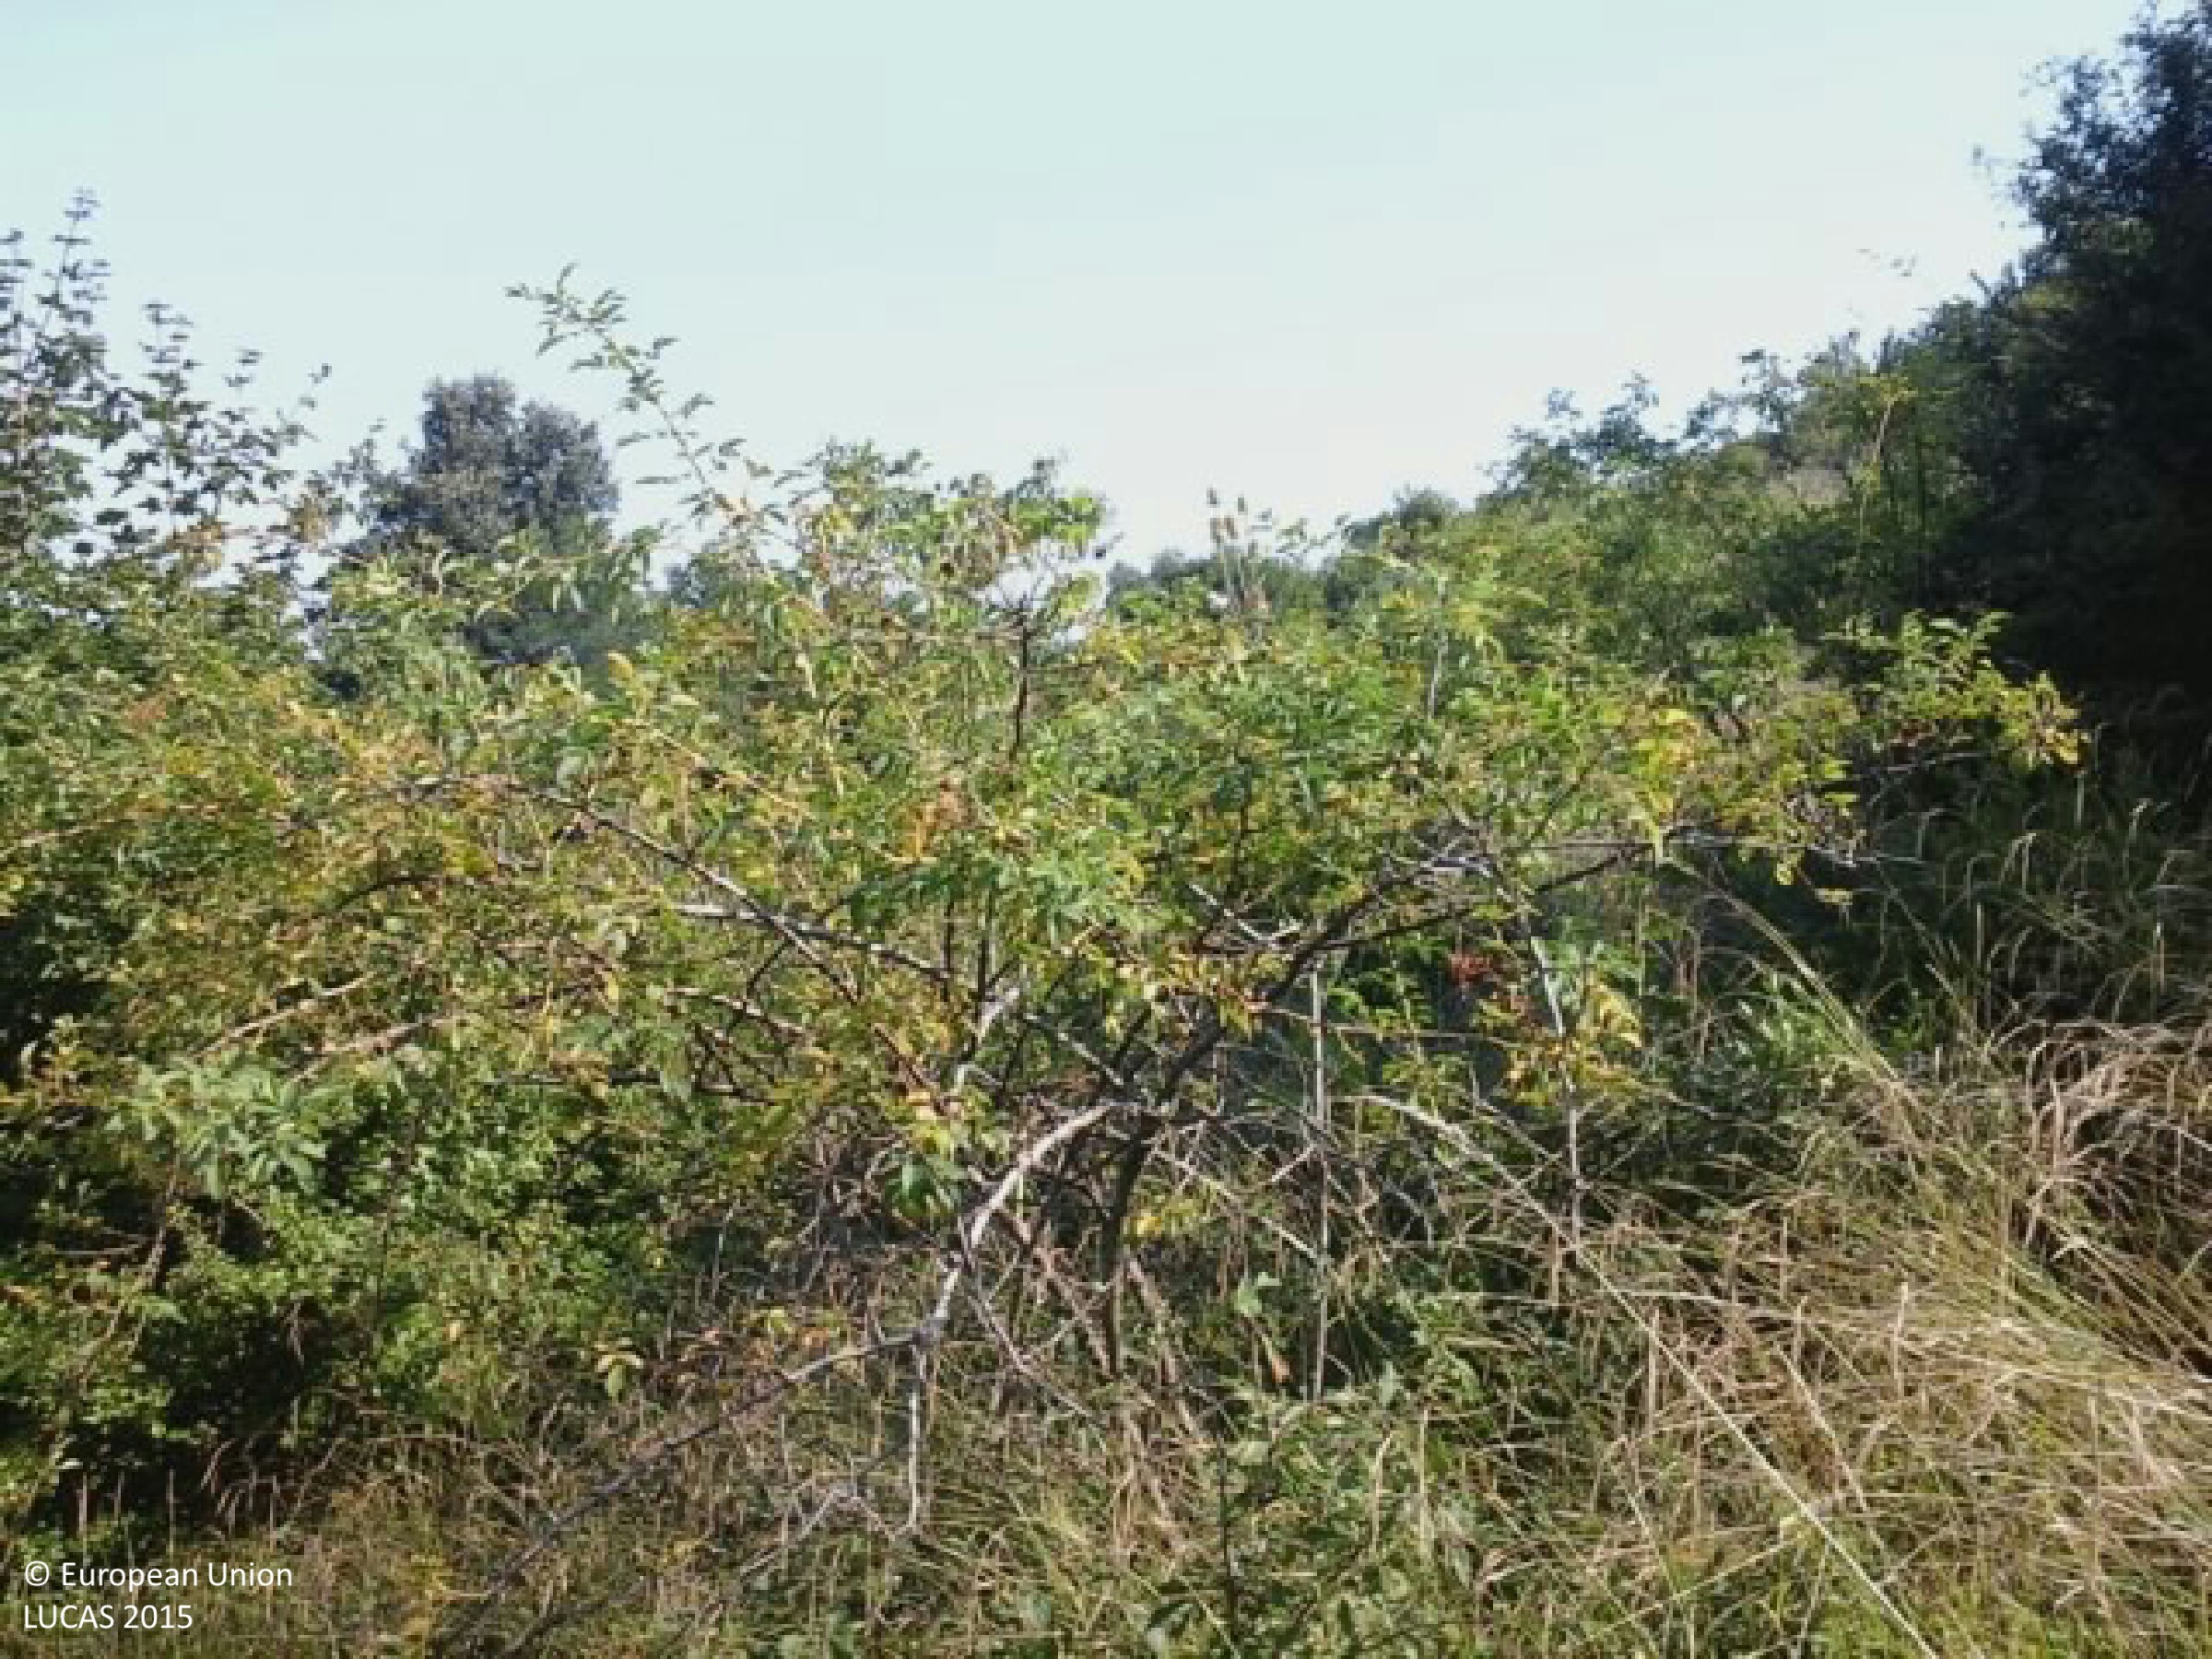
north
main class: Woodland
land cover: Broadleaved woodland
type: mesophytic deciduous forest
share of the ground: > 75 %
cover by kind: broadleaved forest trees 90 %, shrubs 5 %, herbaceous plants 5 %
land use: Forestry
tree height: > 5 m
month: August
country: HU
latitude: 46.2375
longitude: 17.9296
